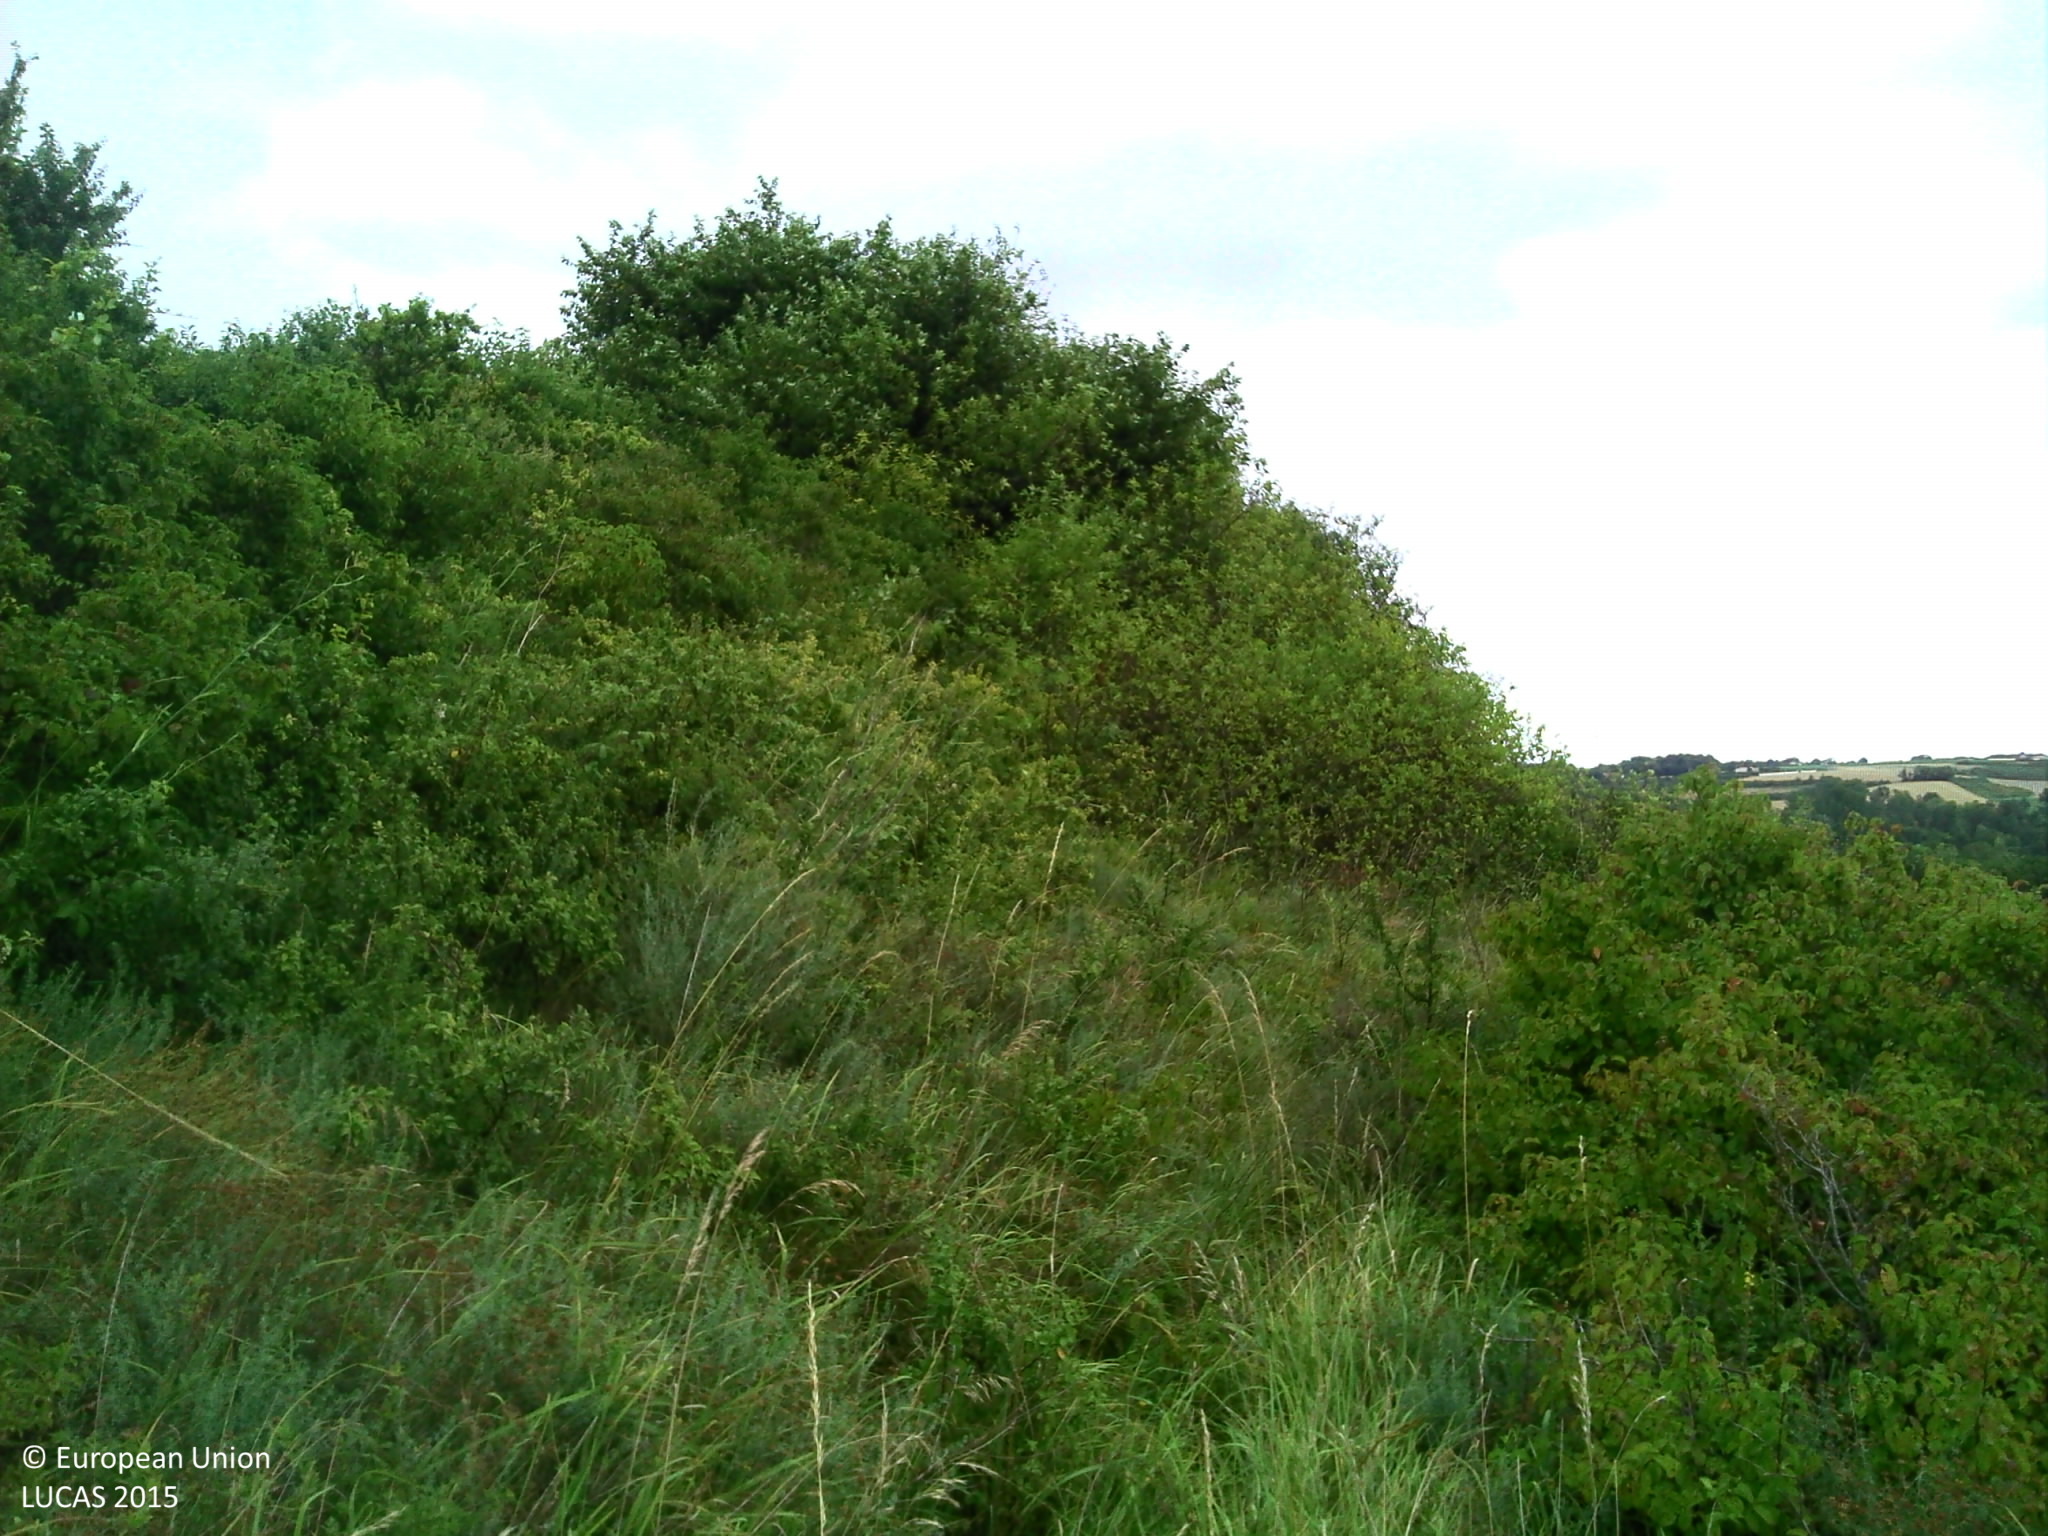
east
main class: Shrubland
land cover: Shrubland without tree cover
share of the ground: > 75 %
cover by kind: shrubs 100 %
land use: Sport
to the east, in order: Shrubland without tree cover; Shrubland with sparse tree cover; Grass margins; Vineyards; Maize; Shrubland without tree cover; Shrubland with sparse tree cover; Grassland with sparse tree/shrub cover; Barley
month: July
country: FR
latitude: 45.4775
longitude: -0.7828
